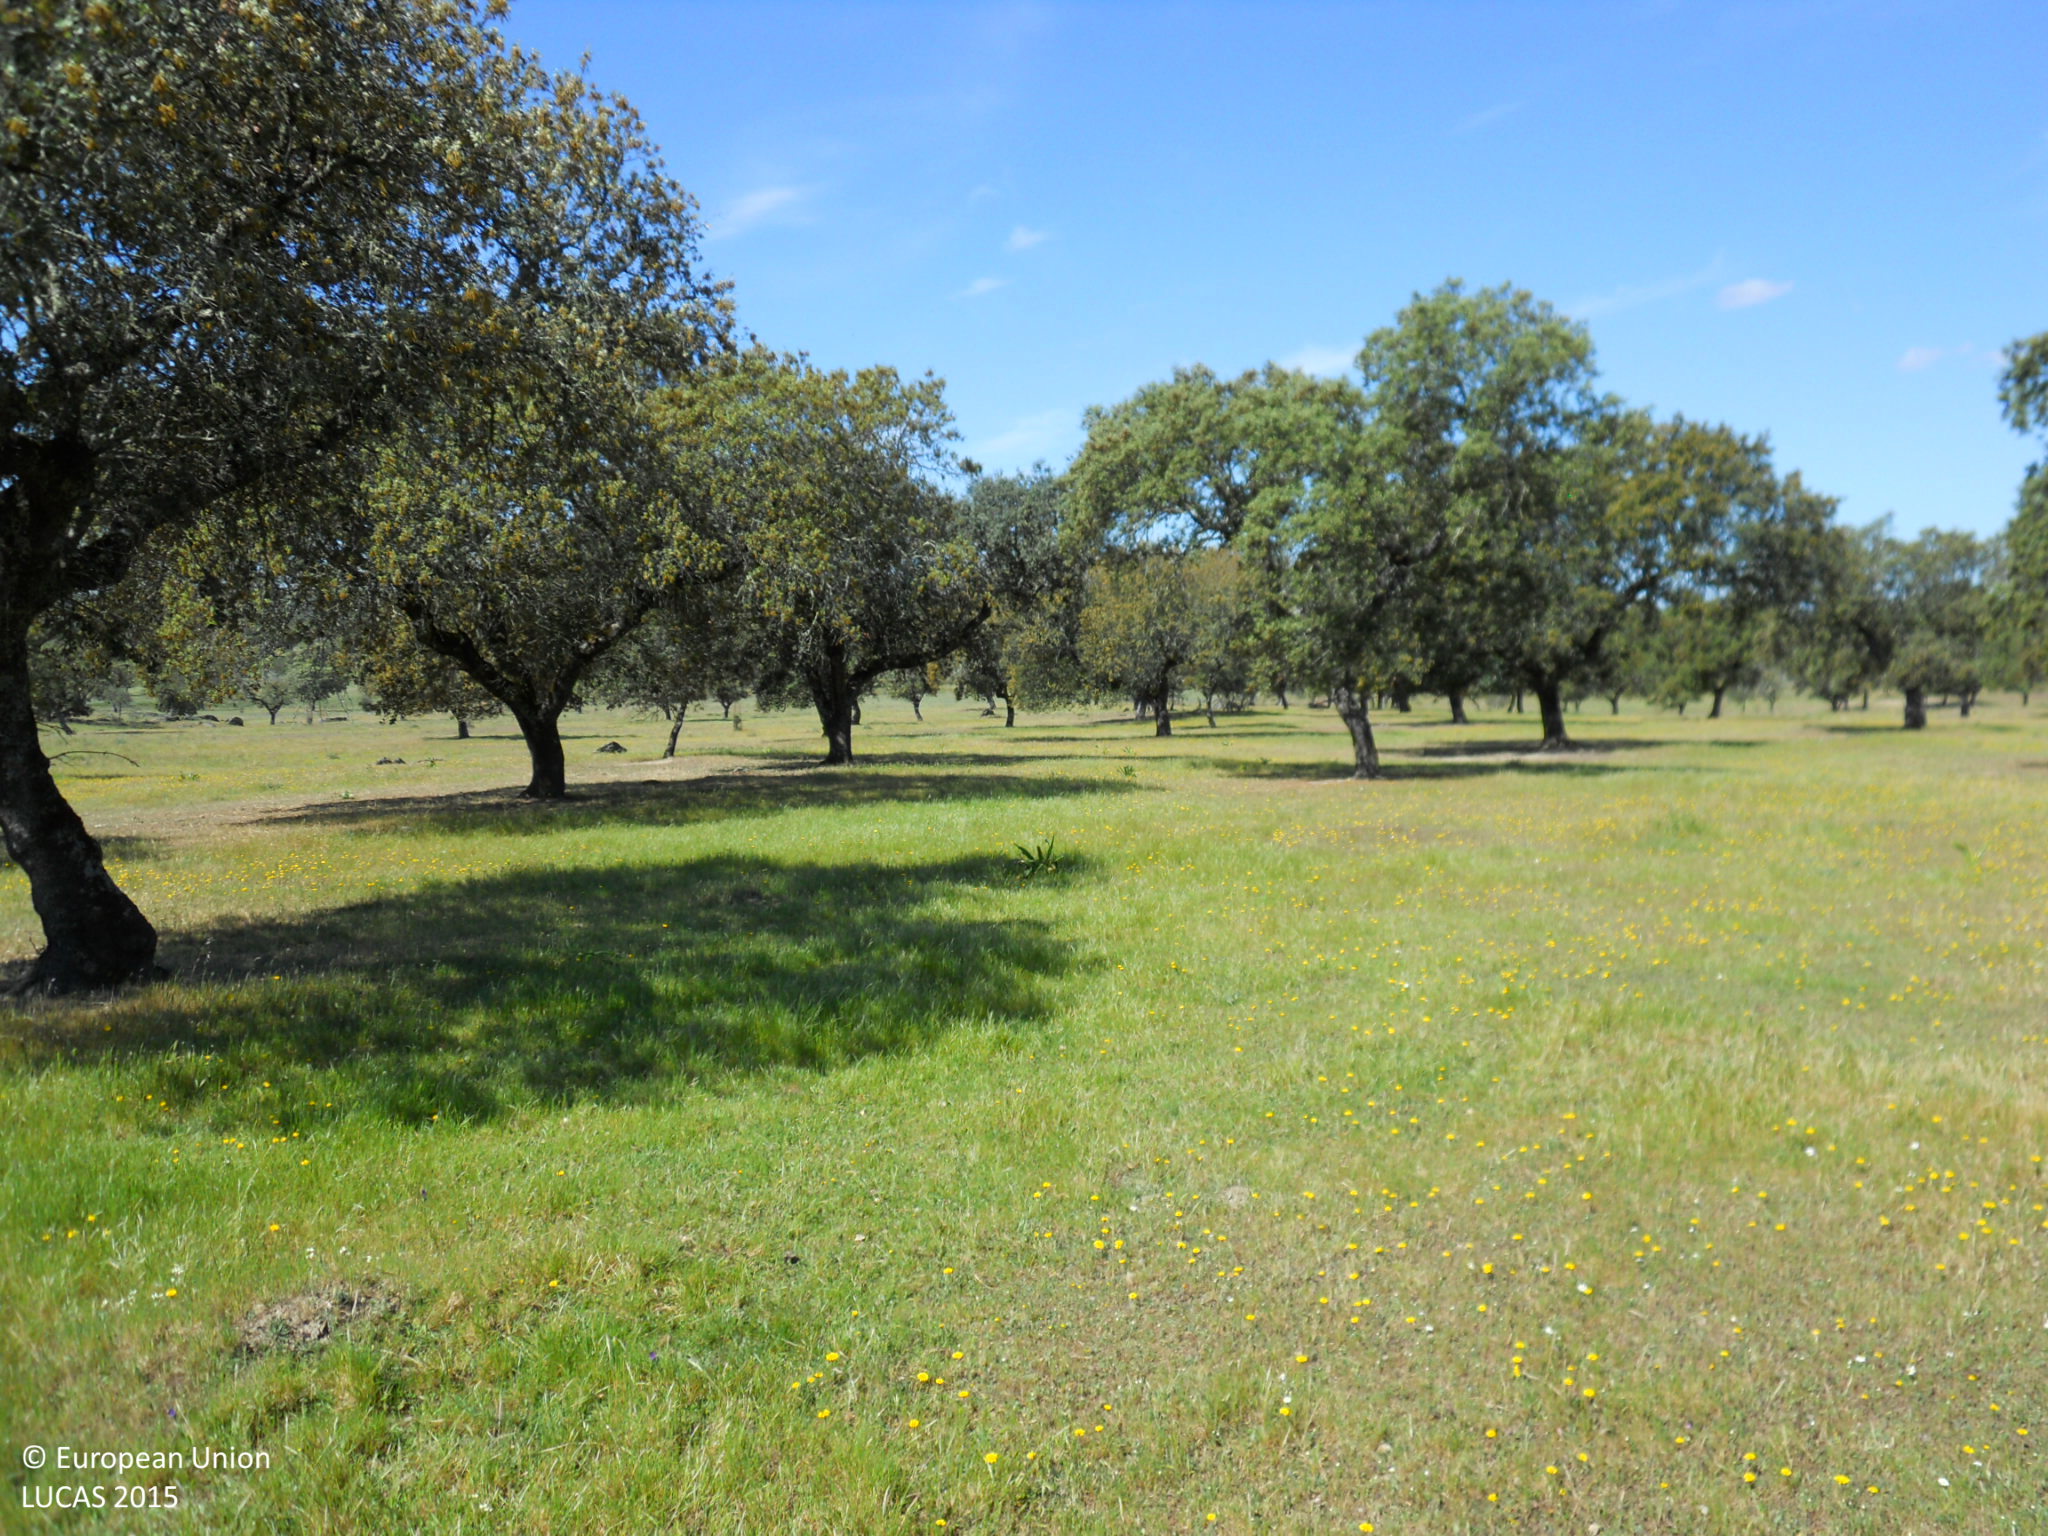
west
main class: Woodland
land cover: Broadleaved woodland
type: broadleaved evergreen forest
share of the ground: 25 - 50 %
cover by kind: herbaceous plants 65 %, broadleaved forest trees 35 %
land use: Forestry
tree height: > 5 m
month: April
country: ES
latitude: 39.3418
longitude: -7.0074
